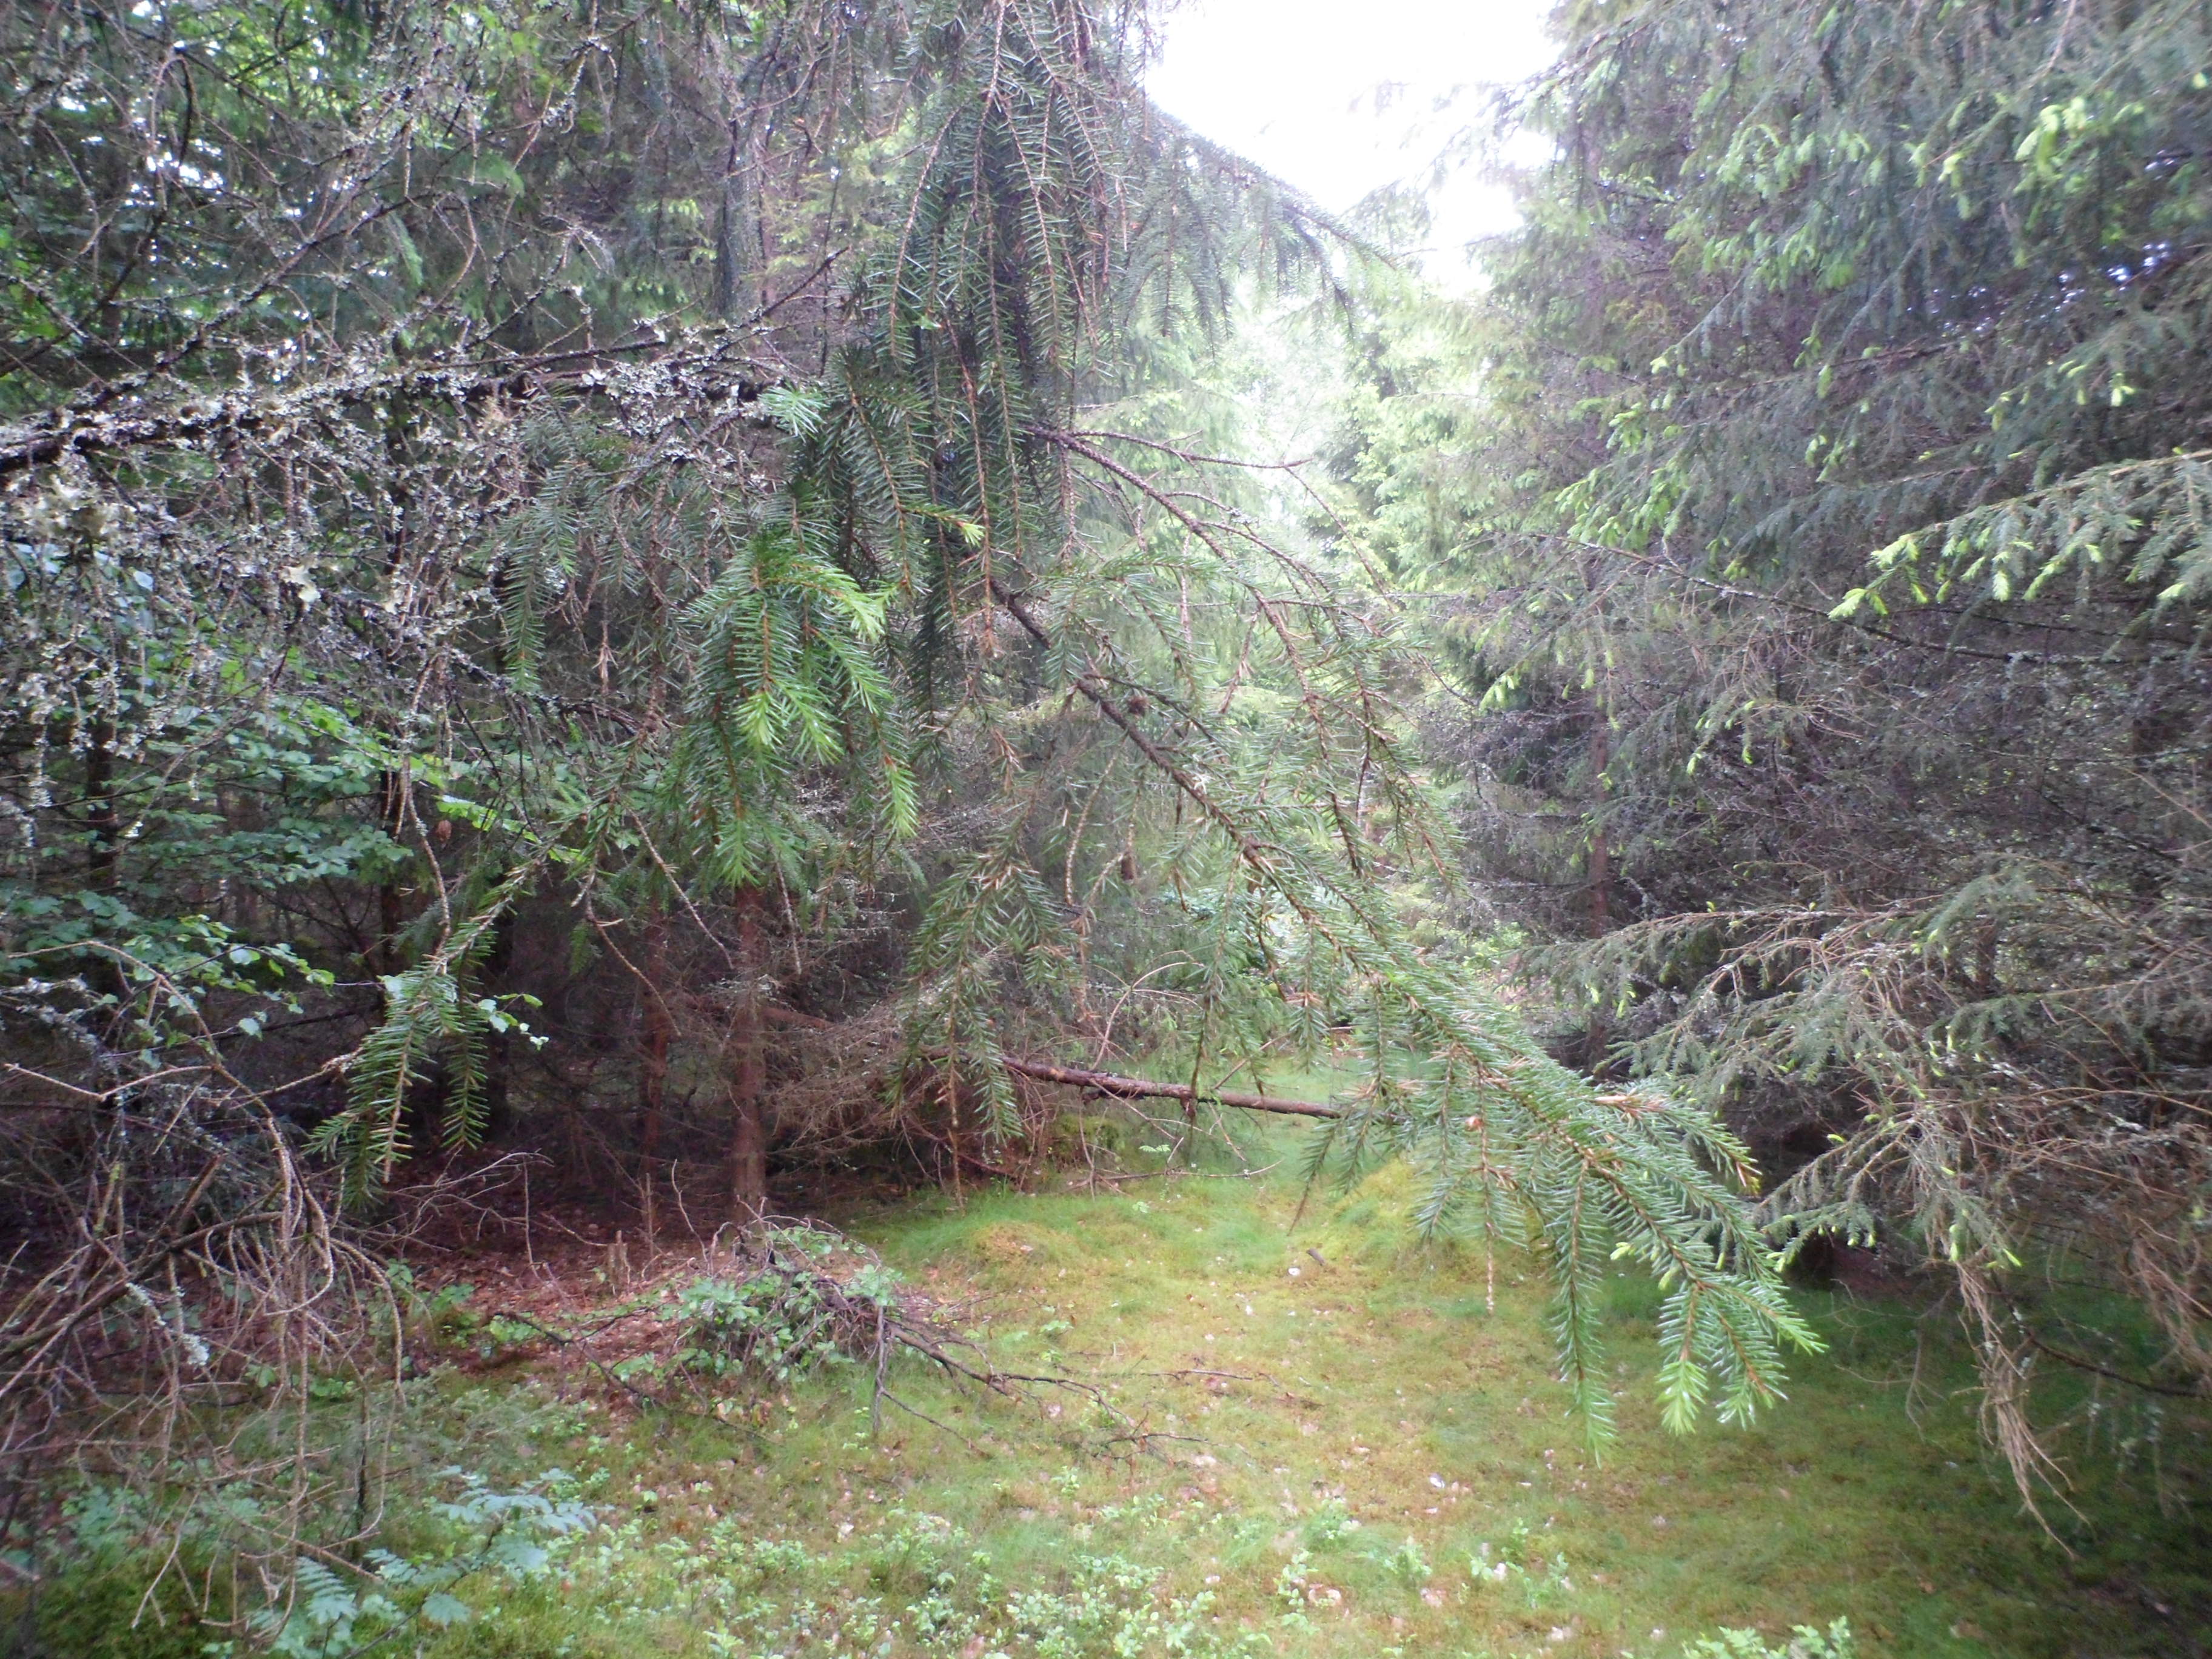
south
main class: Woodland
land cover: Spruce dominated coniferous woodland
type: boreal forest
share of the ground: 50 - 75 %
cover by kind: coniferous forest trees 50 %, lichens and mosses 25 %, broadleaved forest trees 10 %, shrubs 10 %, herbaceous plants 5 %
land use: Forestry
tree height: > 5 m
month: June
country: SE
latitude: 56.9423
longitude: 14.3525
